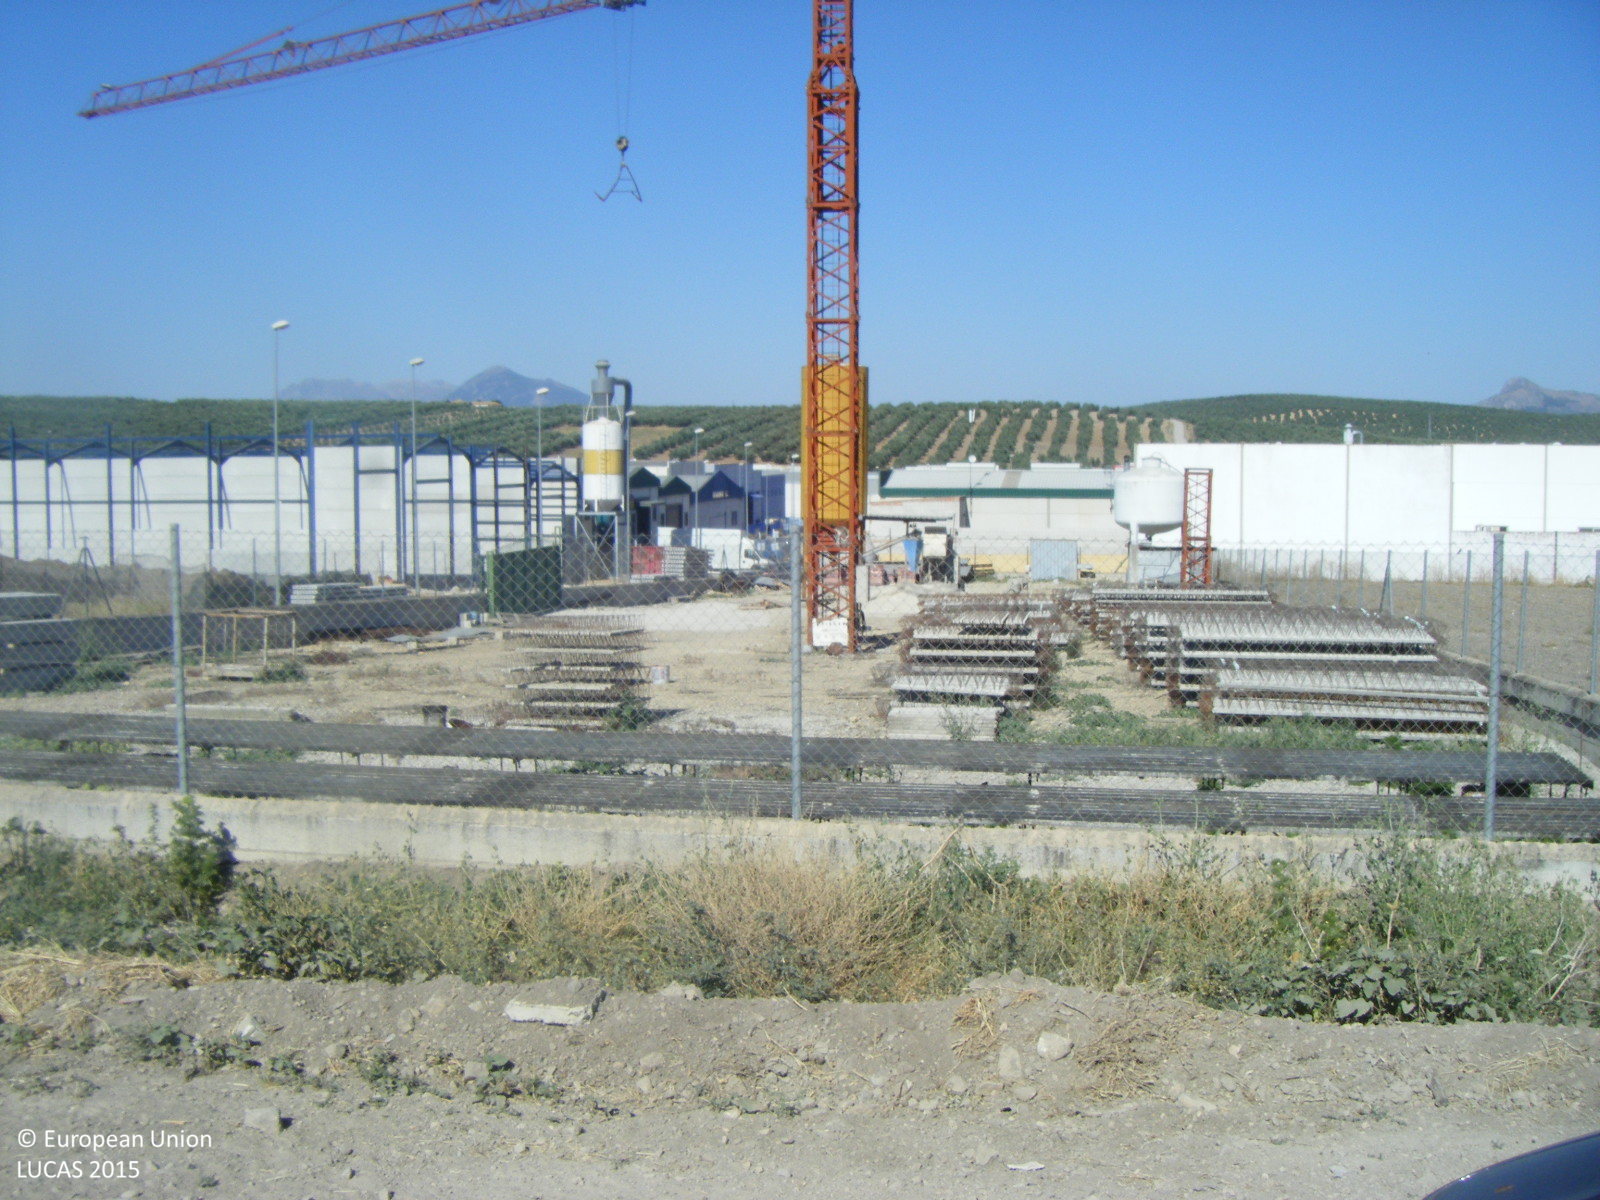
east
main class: Cropland
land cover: Olive groves
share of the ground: 10 - 25 %
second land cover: Other bare soil
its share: > 75 %
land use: Agriculture (excluding fallow land and kitchen gardens)
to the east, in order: Fences; Spontaneously vegetated surfaces; Other bare soil; Tracks; Shruby margins; Other bare soil; Artificial constructions in urban areas
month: June
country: ES
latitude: 37.2678
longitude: -4.5364
